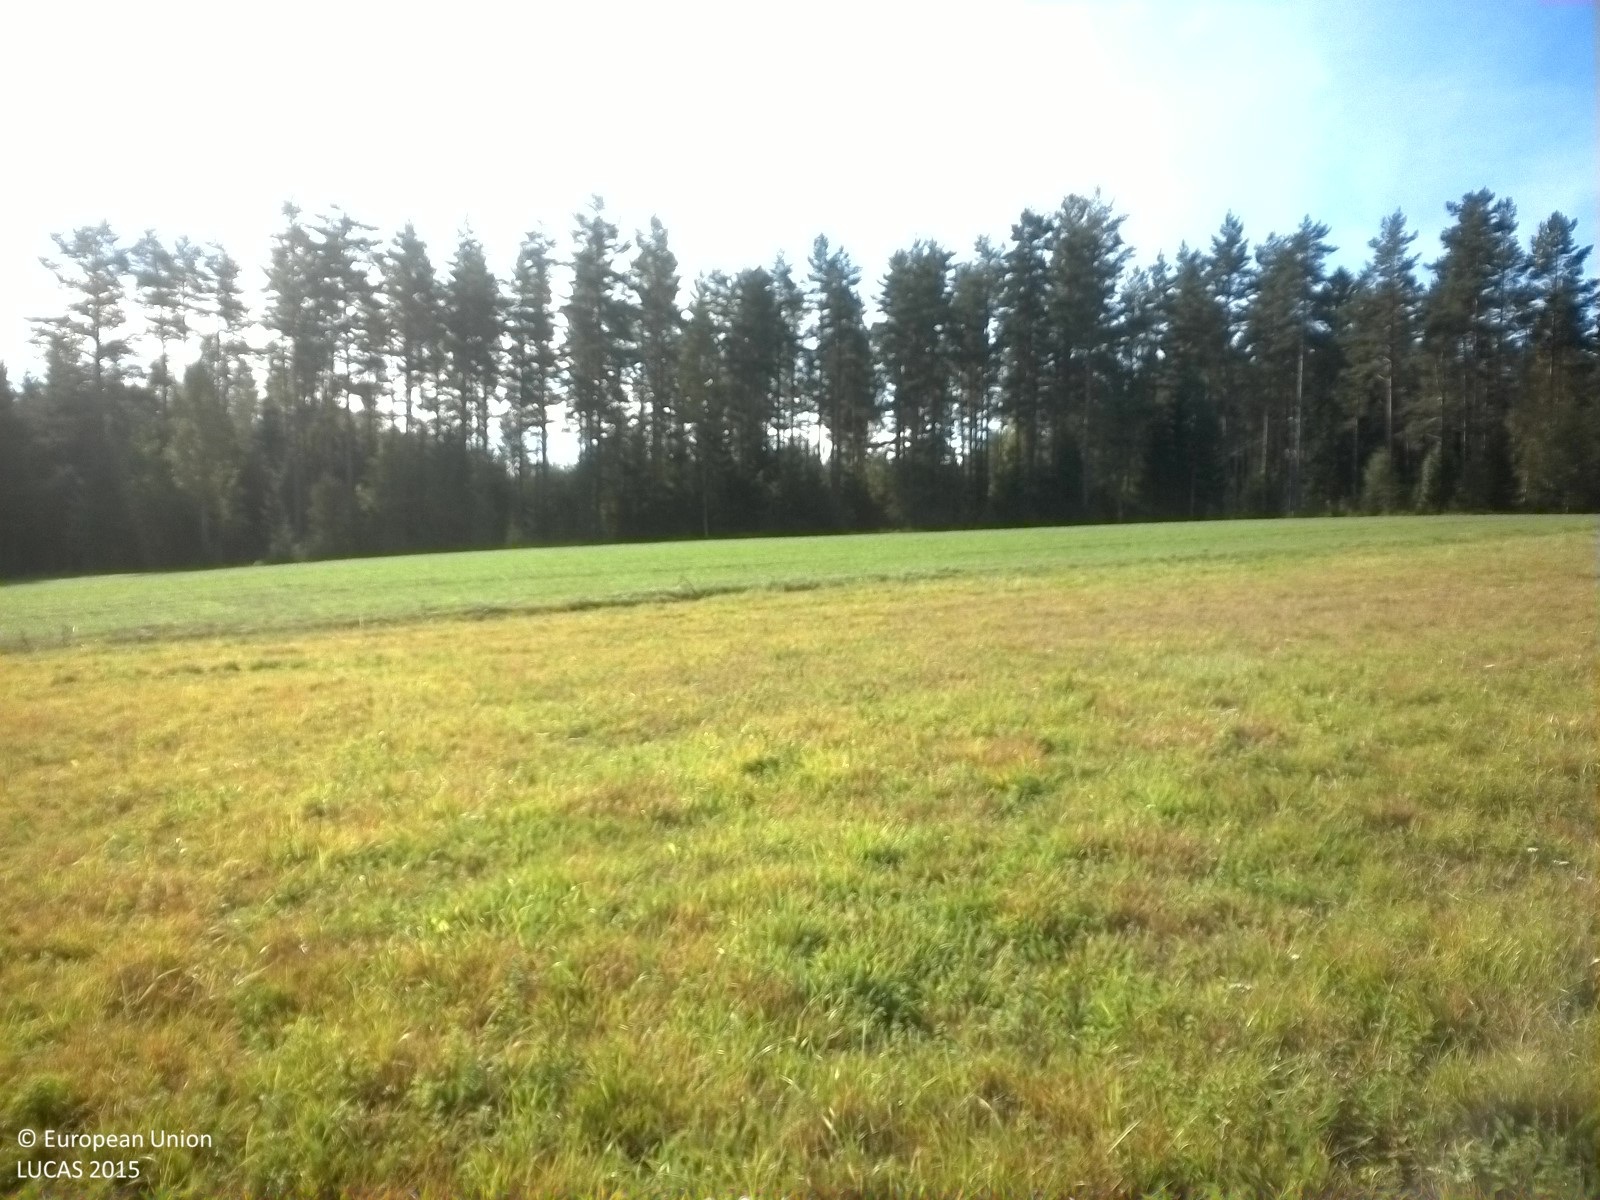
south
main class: Grassland
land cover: Grassland without tree/shrub cover
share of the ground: > 75 %
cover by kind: herbaceous plants 100 %
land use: Agriculture (excluding fallow land and kitchen gardens)
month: September
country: SE
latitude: 58.9834
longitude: 15.6824
